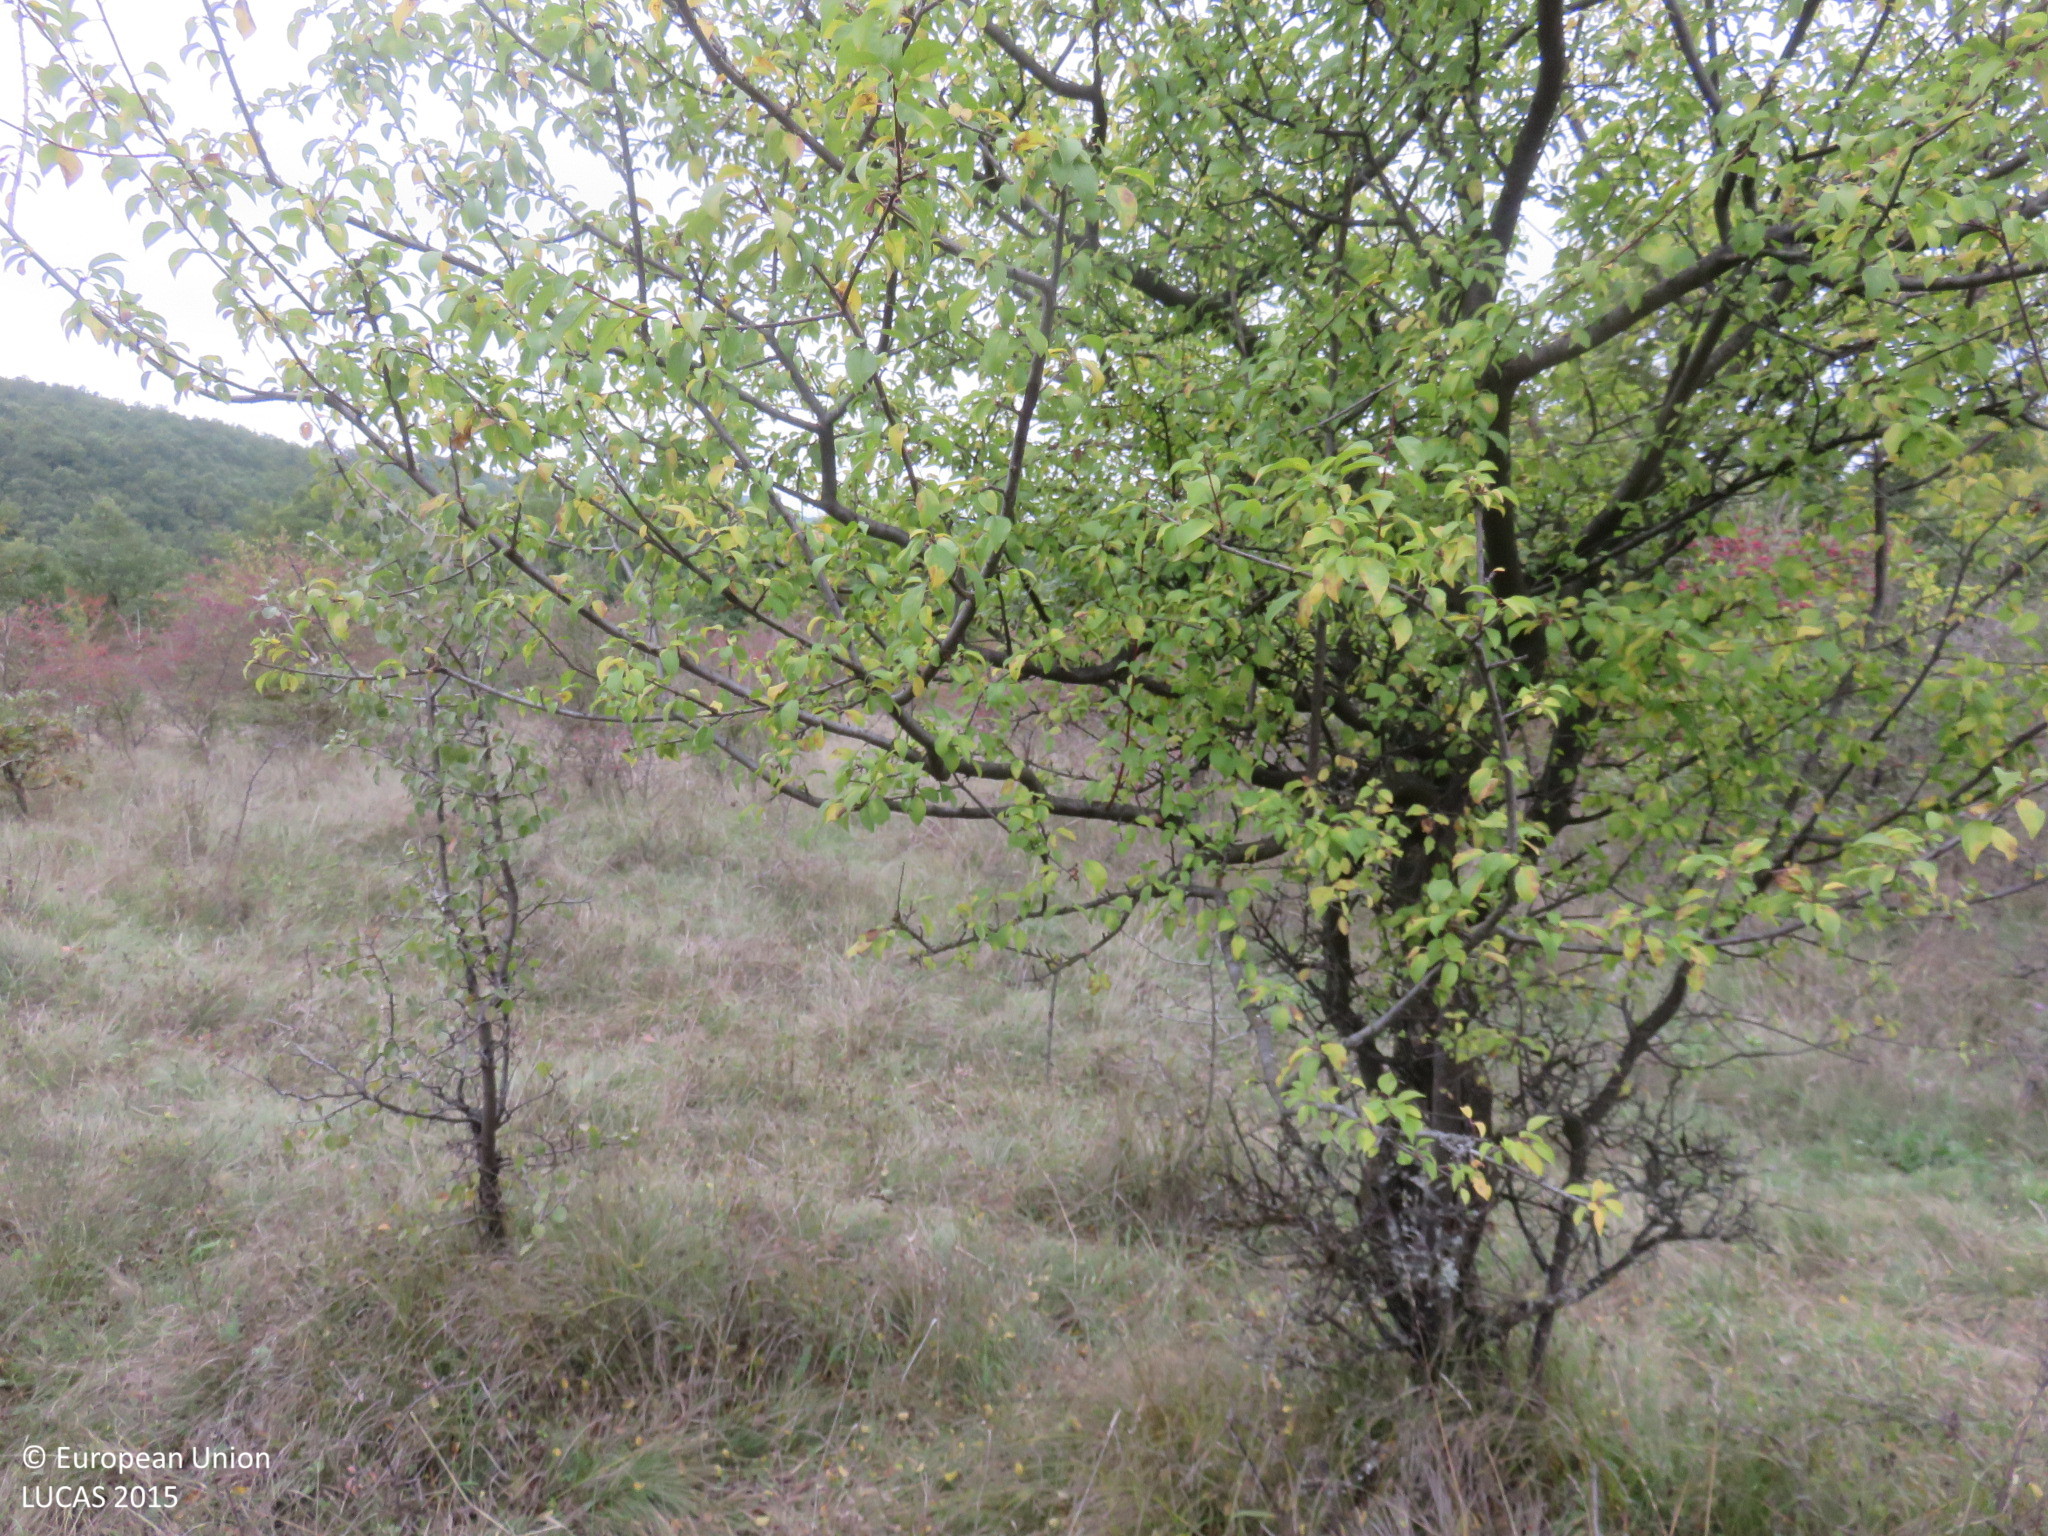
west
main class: Shrubland
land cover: Shrubland with sparse tree cover
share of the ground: > 75 %
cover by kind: shrubs 95 %, broadleaved forest trees 5 %
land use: Semi-natural and natural areas not in use
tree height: < 5 m
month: October
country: BG
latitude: 43.0140
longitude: 25.2483
